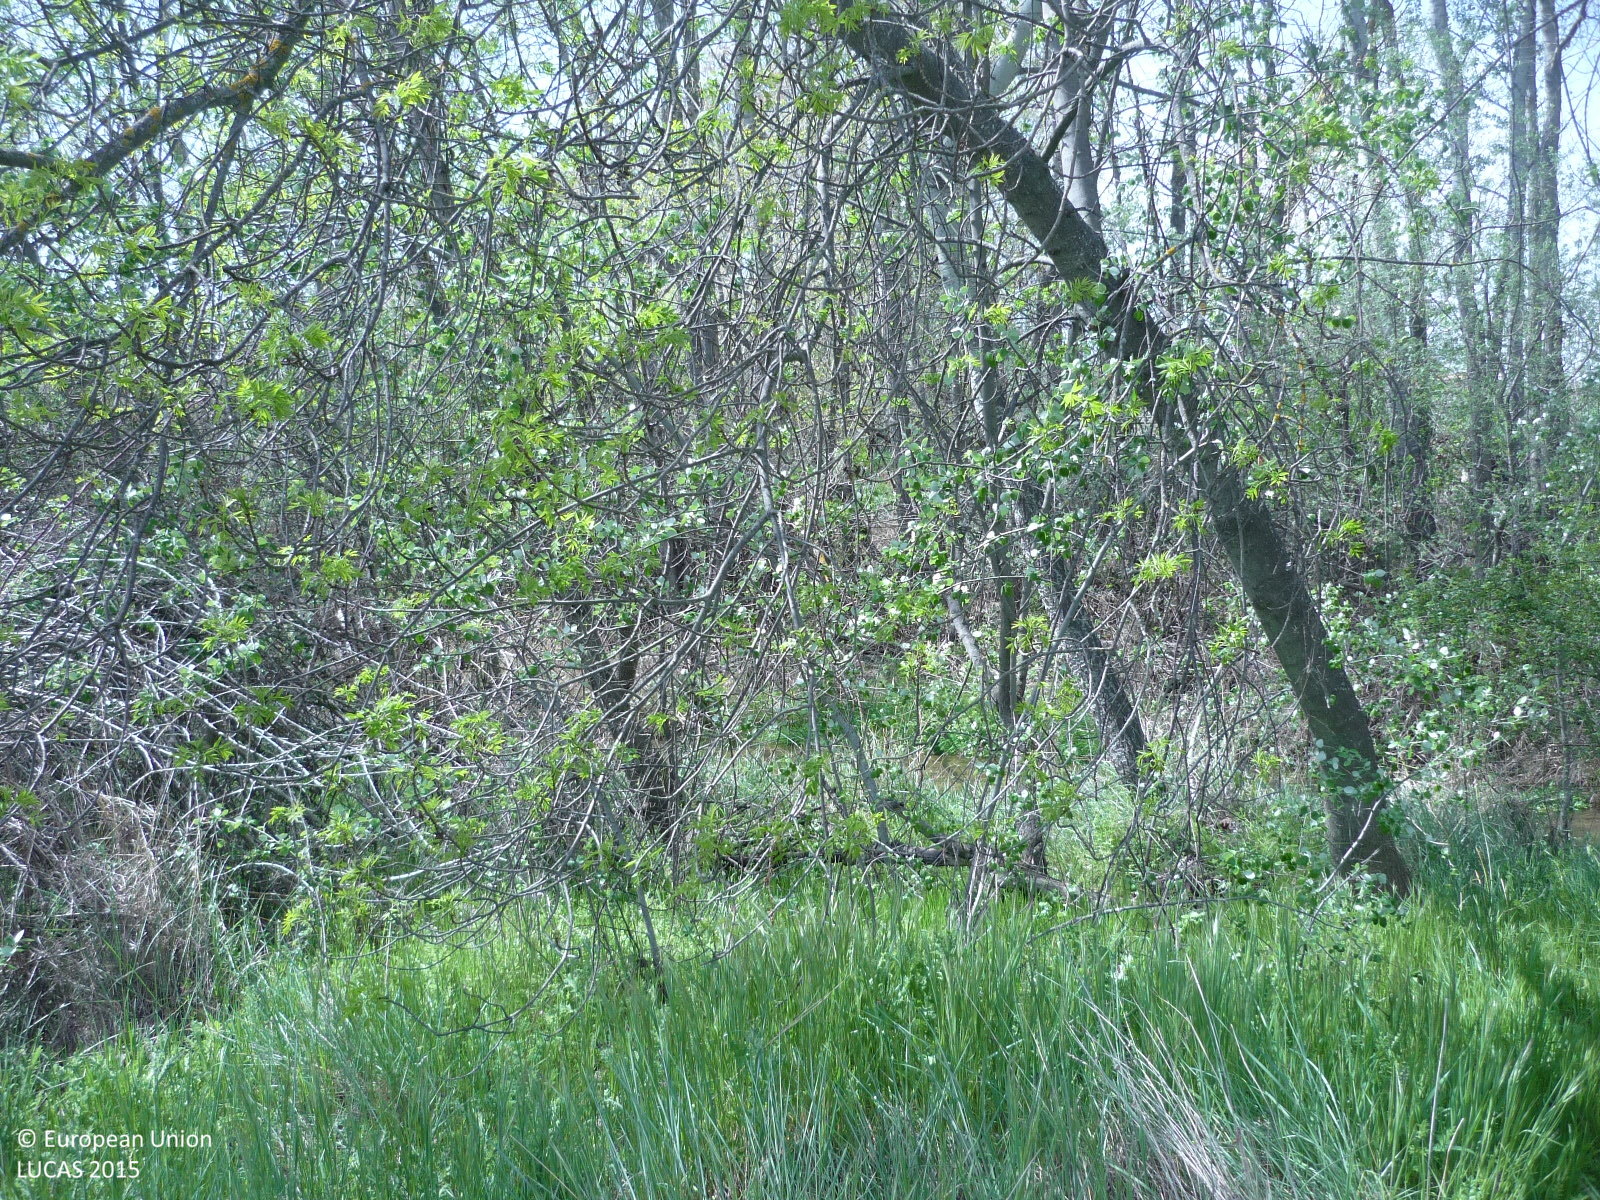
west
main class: Woodland
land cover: Broadleaved woodland
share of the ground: > 75 %
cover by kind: broadleaved forest trees 80 %, herbaceous plants 15 %, consolidated bare surface 5 %
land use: Semi-natural and natural areas not in use
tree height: > 5 m
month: April
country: ES
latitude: 40.4933
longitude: -3.4263
